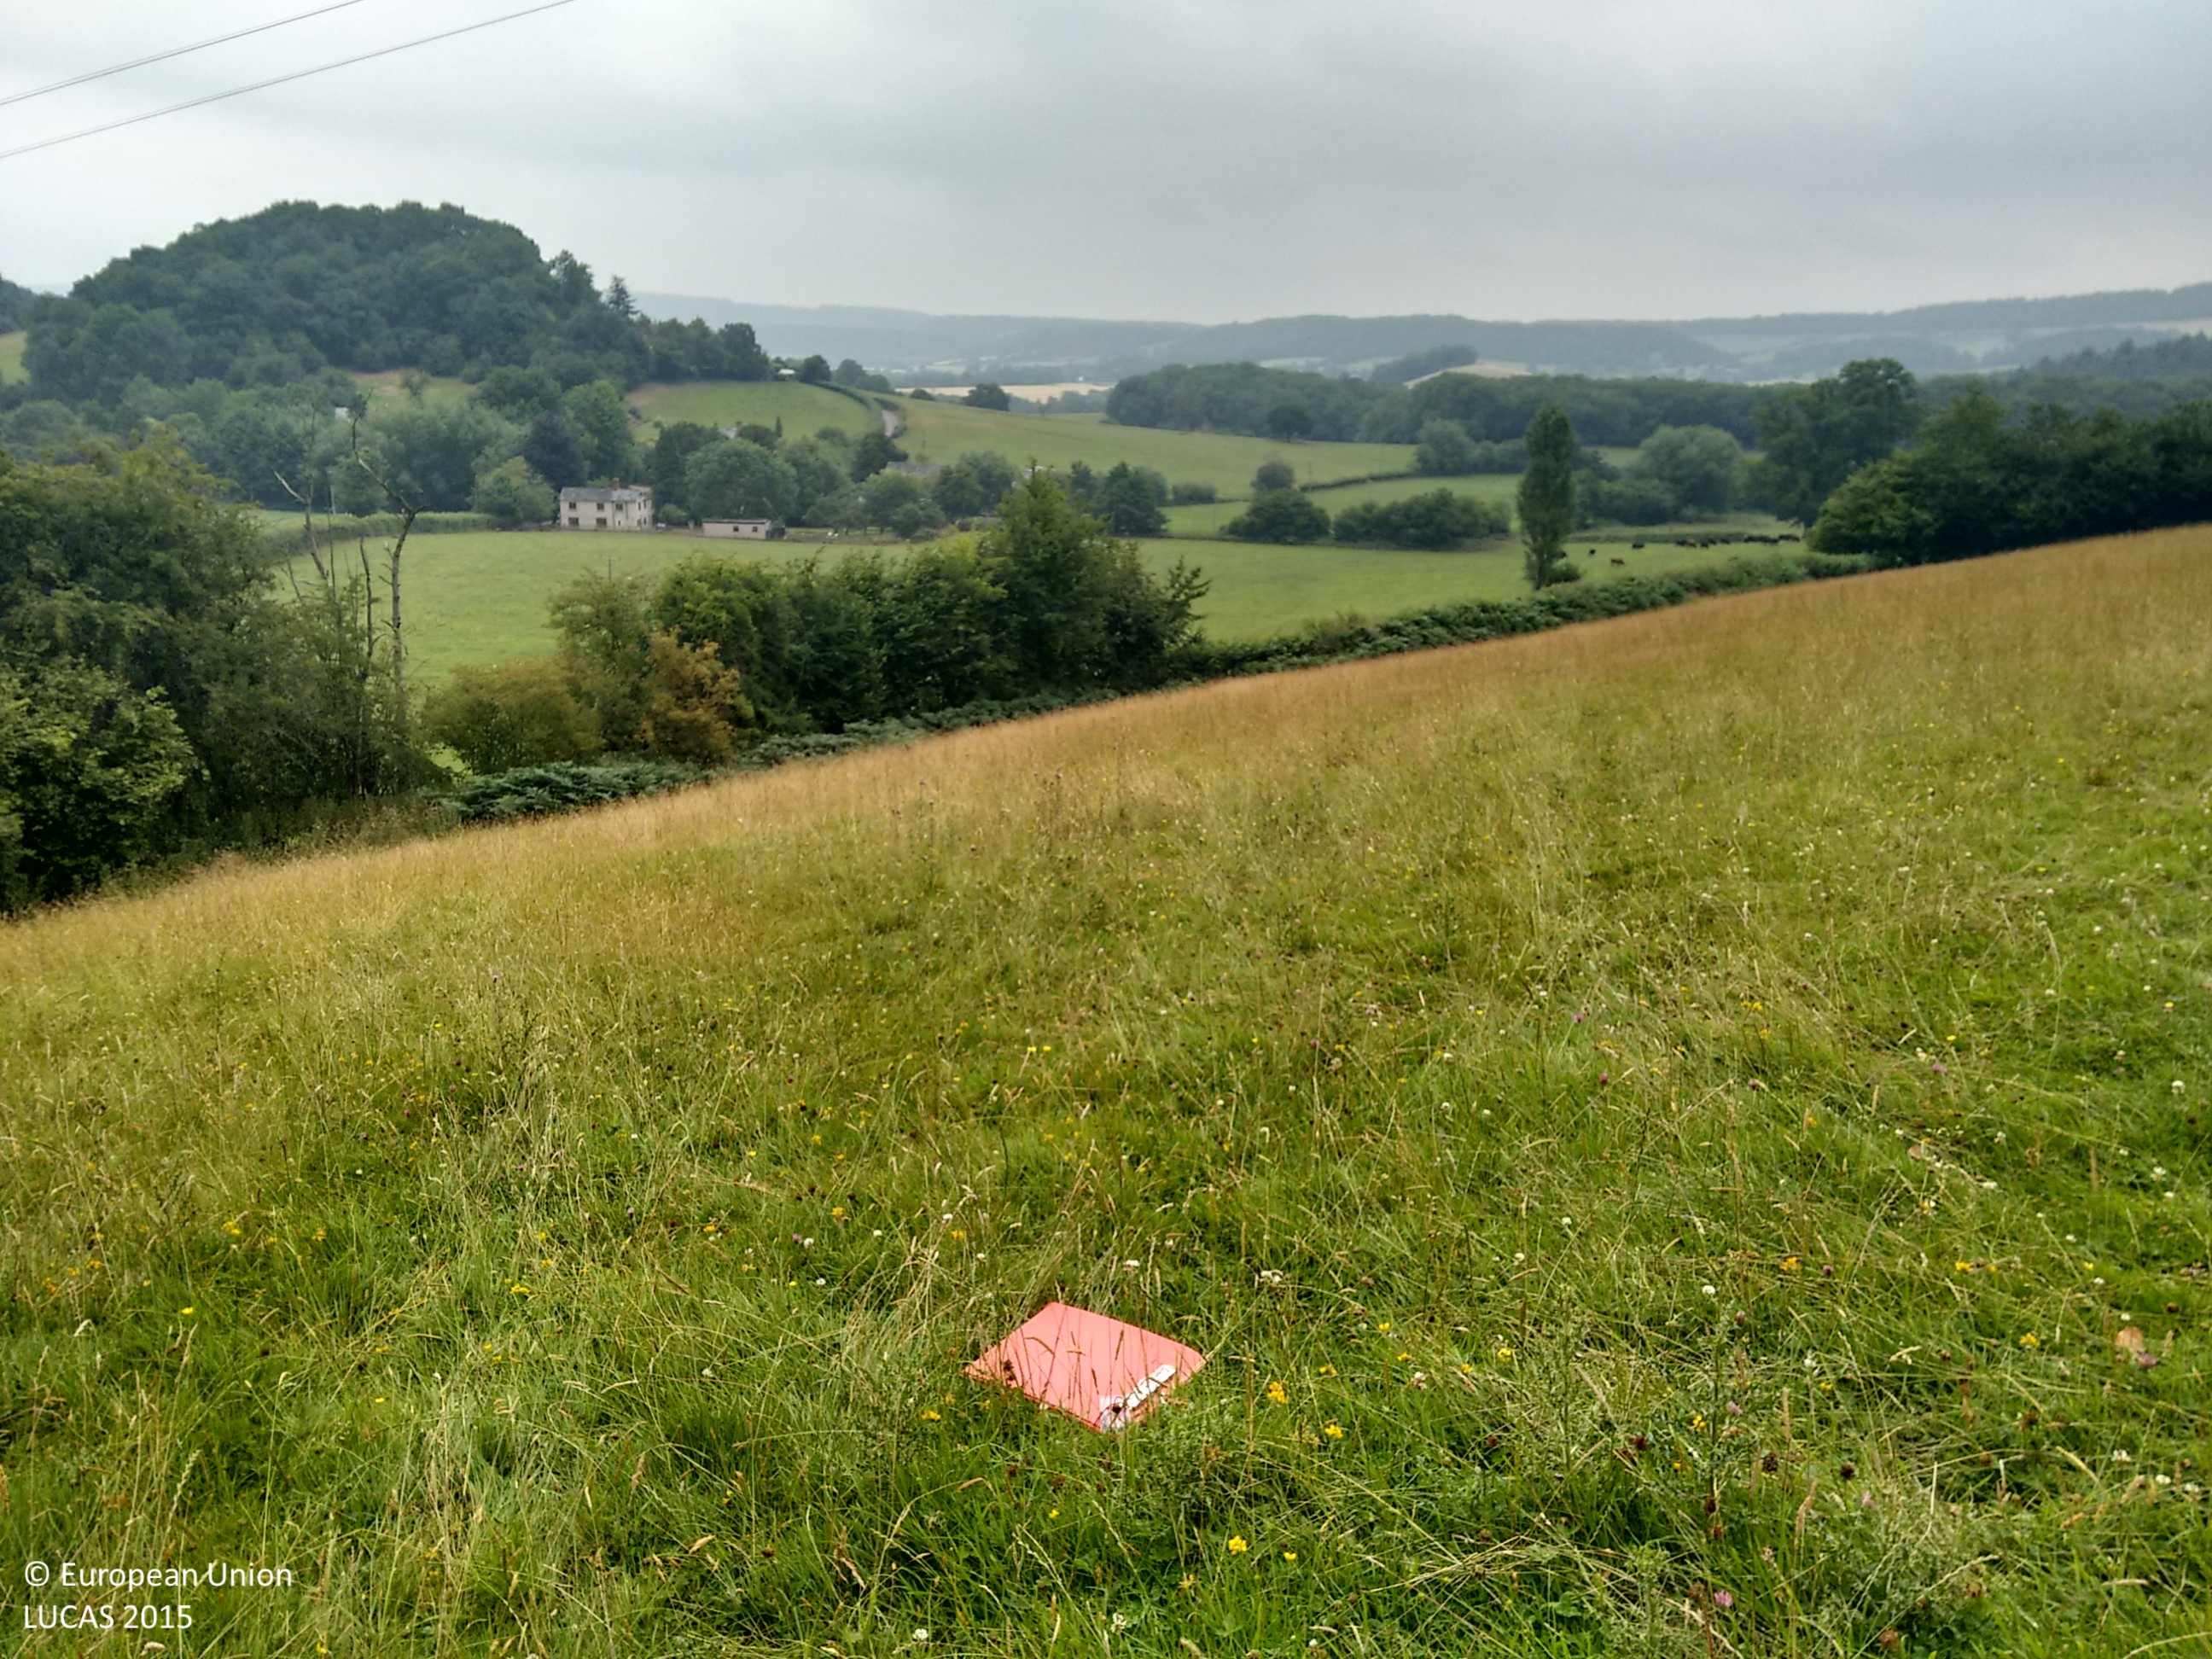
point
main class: Grassland
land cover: Grassland without tree/shrub cover
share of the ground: > 75 %
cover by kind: herbaceous plants 100 %
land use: Agriculture (excluding fallow land and kitchen gardens)
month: July
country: GB
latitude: 51.9963
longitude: -2.5788
